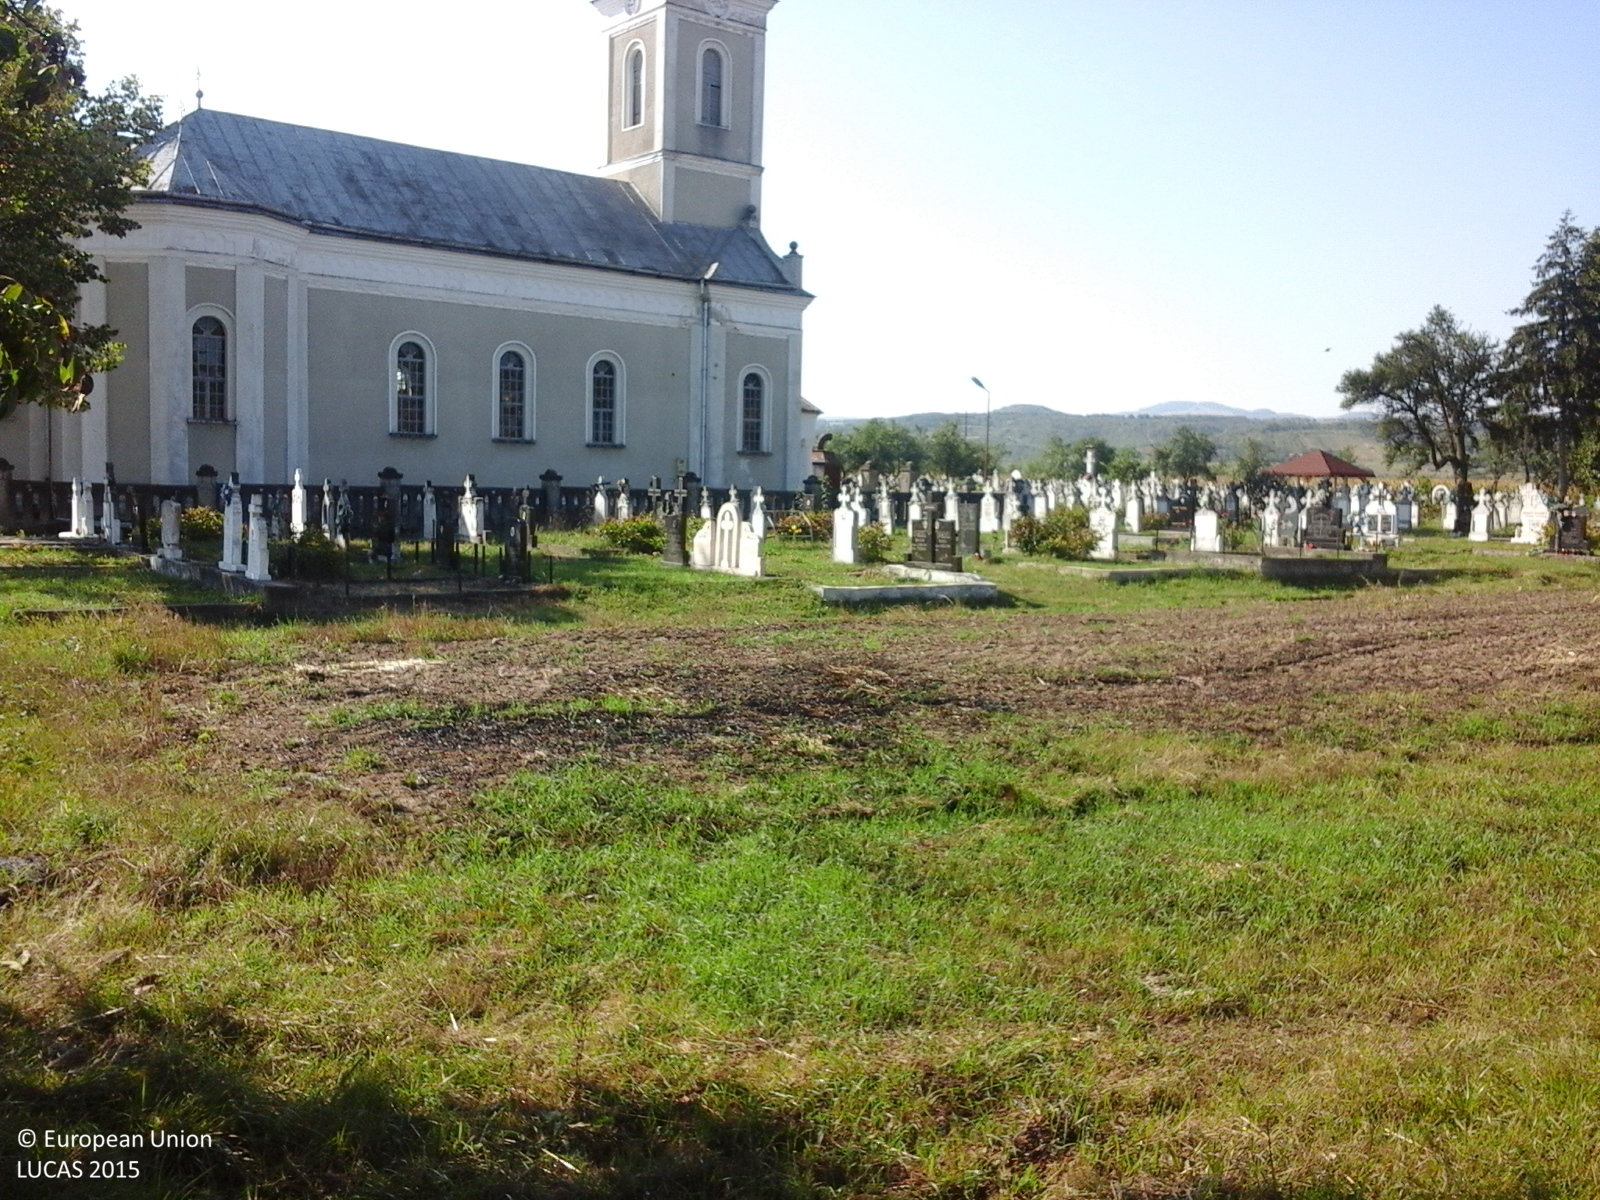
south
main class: Cropland
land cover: Other fruit trees and berries
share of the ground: > 75 %
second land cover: Grassland without tree/shrub cover
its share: > 75 %
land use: Kitchen garden
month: September
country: RO
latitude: 46.5520
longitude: 22.4282
